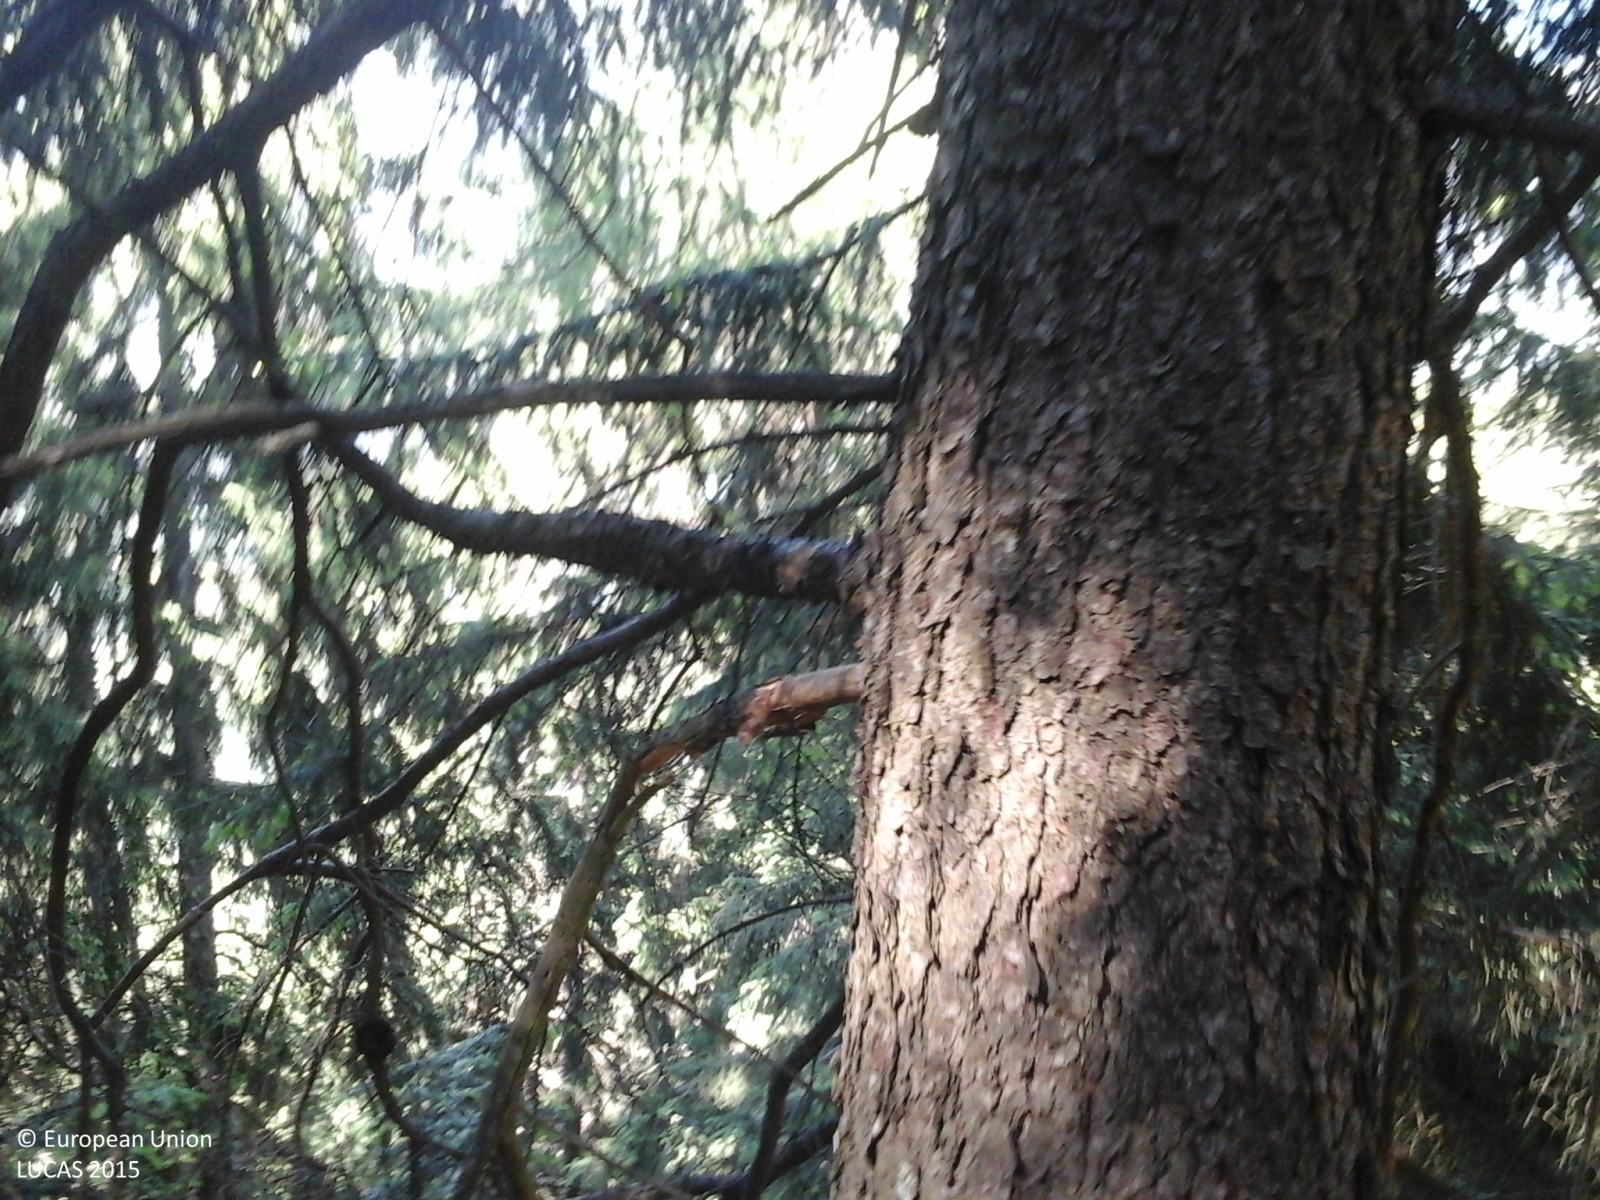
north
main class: Woodland
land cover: Spruce dominated coniferous woodland
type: alpine coniferous forest
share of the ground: > 75 %
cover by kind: coniferous forest trees 100 %
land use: Forestry
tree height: > 5 m
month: May
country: IT
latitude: 46.6000
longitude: 10.8475
